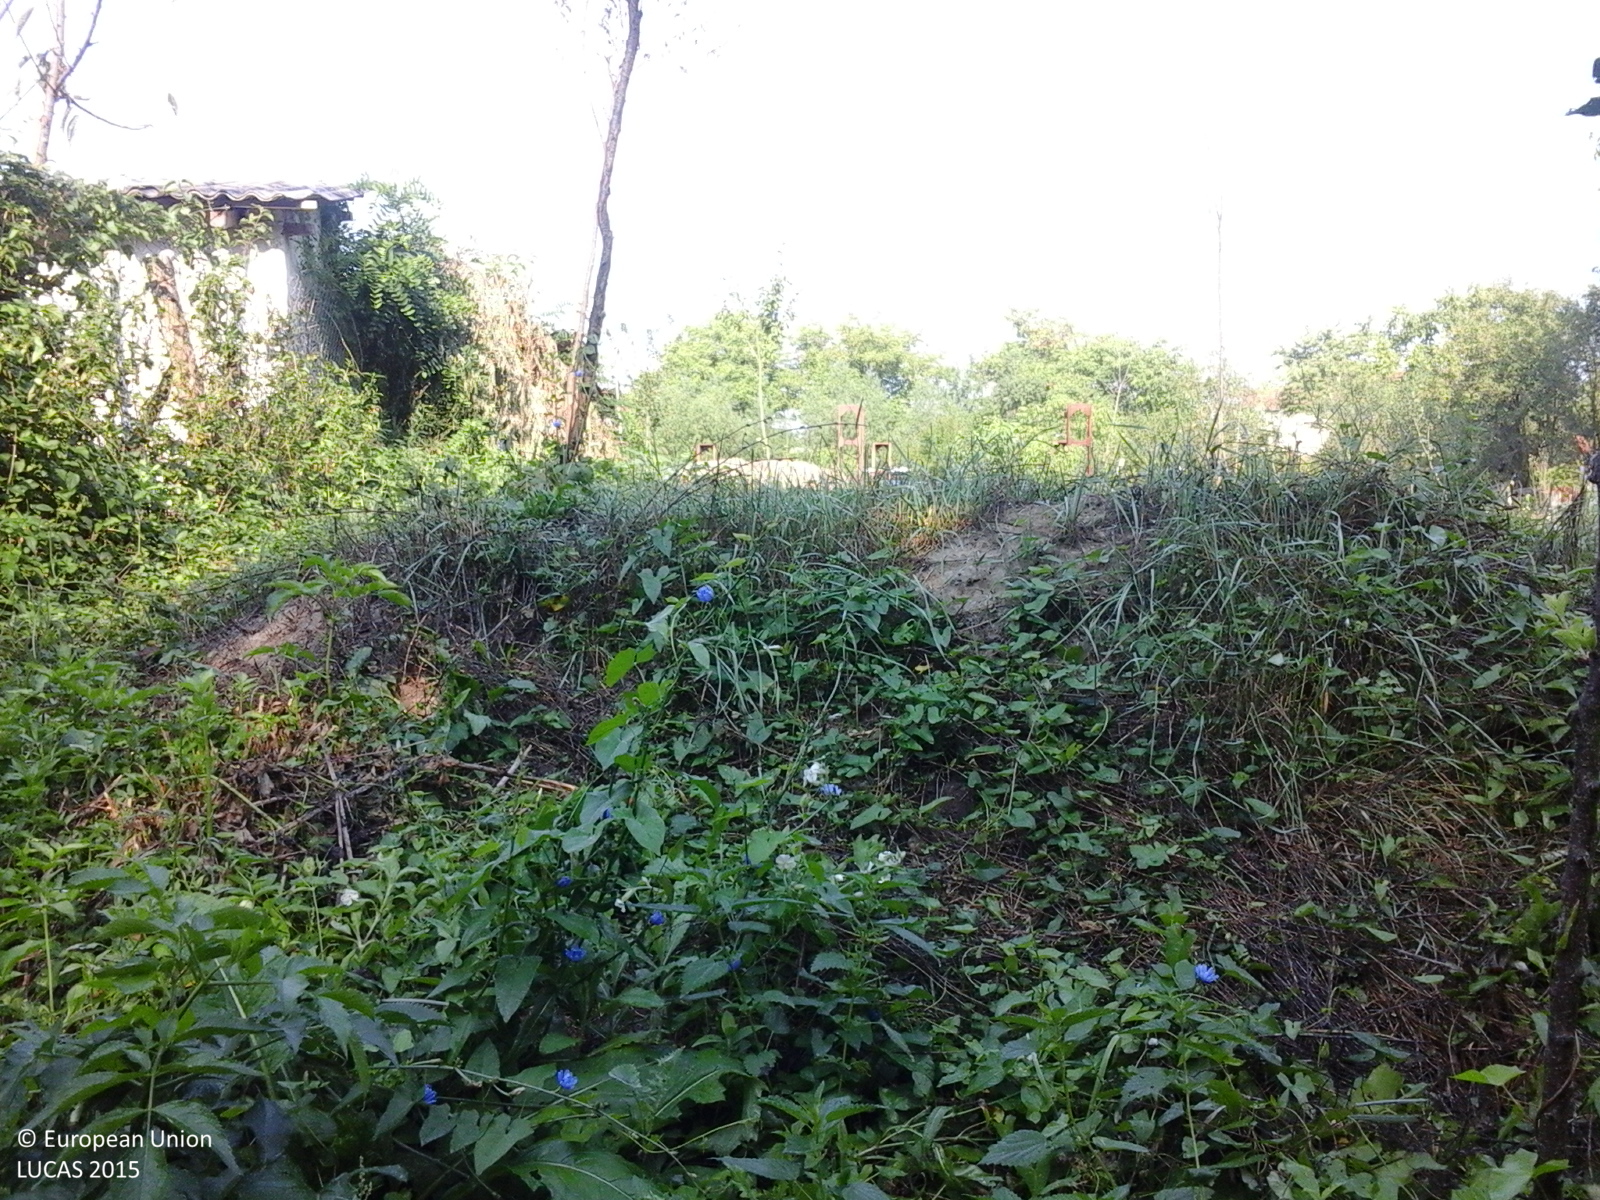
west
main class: Woodland
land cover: Broadleaved woodland
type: broadleaved evergreen forest
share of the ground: > 75 %
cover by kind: broadleaved forest trees 100 %
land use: Forestry
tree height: > 5 m
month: August
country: RO
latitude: 46.2744
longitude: 22.3104
